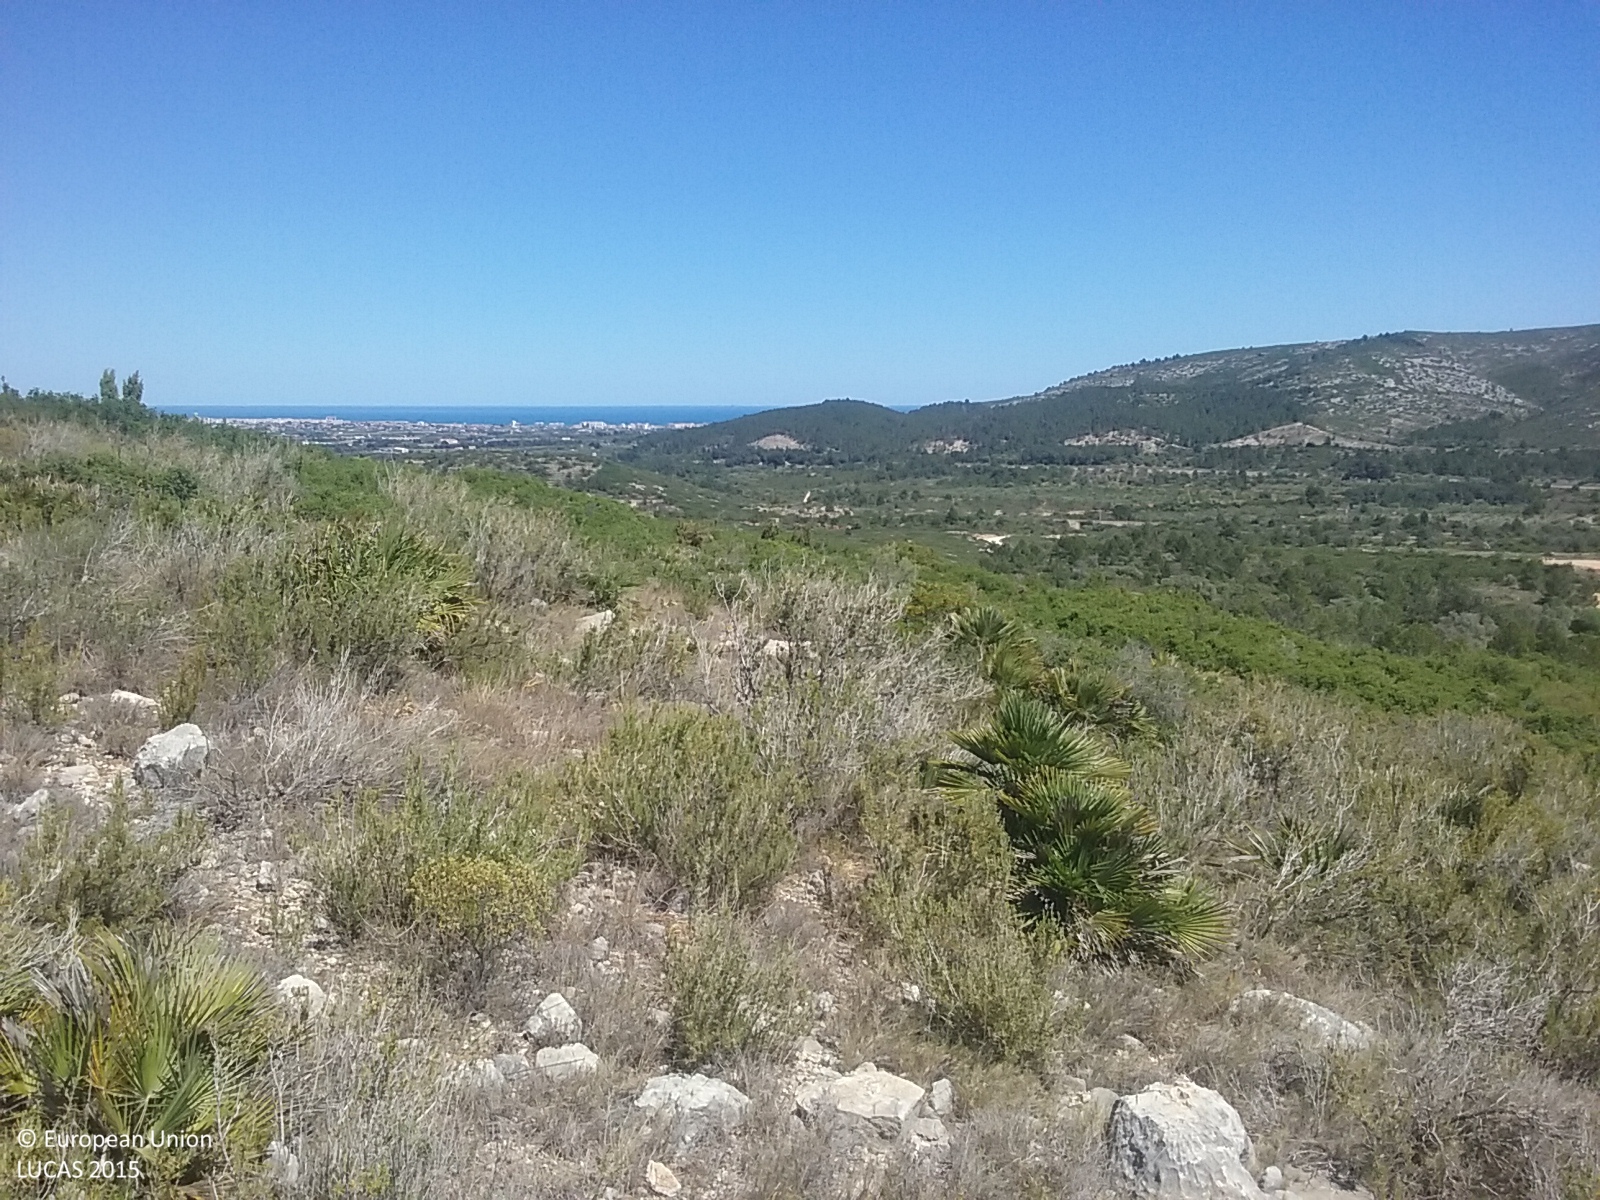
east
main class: Shrubland
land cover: Shrubland with sparse tree cover
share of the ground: > 75 %
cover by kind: shrubs 90 %, broadleaved forest trees 5 %
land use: Semi-natural and natural areas not in use
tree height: < 5 m
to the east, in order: Shrubland with sparse tree cover; Tracks; Shrubland without tree cover; Dry stone walls; Shrubland without tree cover; Dry stone walls; Permanent industrial crops; Dry stone walls; Permanent industrial crops; Dry stone walls; Pine dominated coniferous woodland; Dry stone walls; Pine dominated coniferous woodland
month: May
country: ES
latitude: 40.3890
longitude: 0.3251
